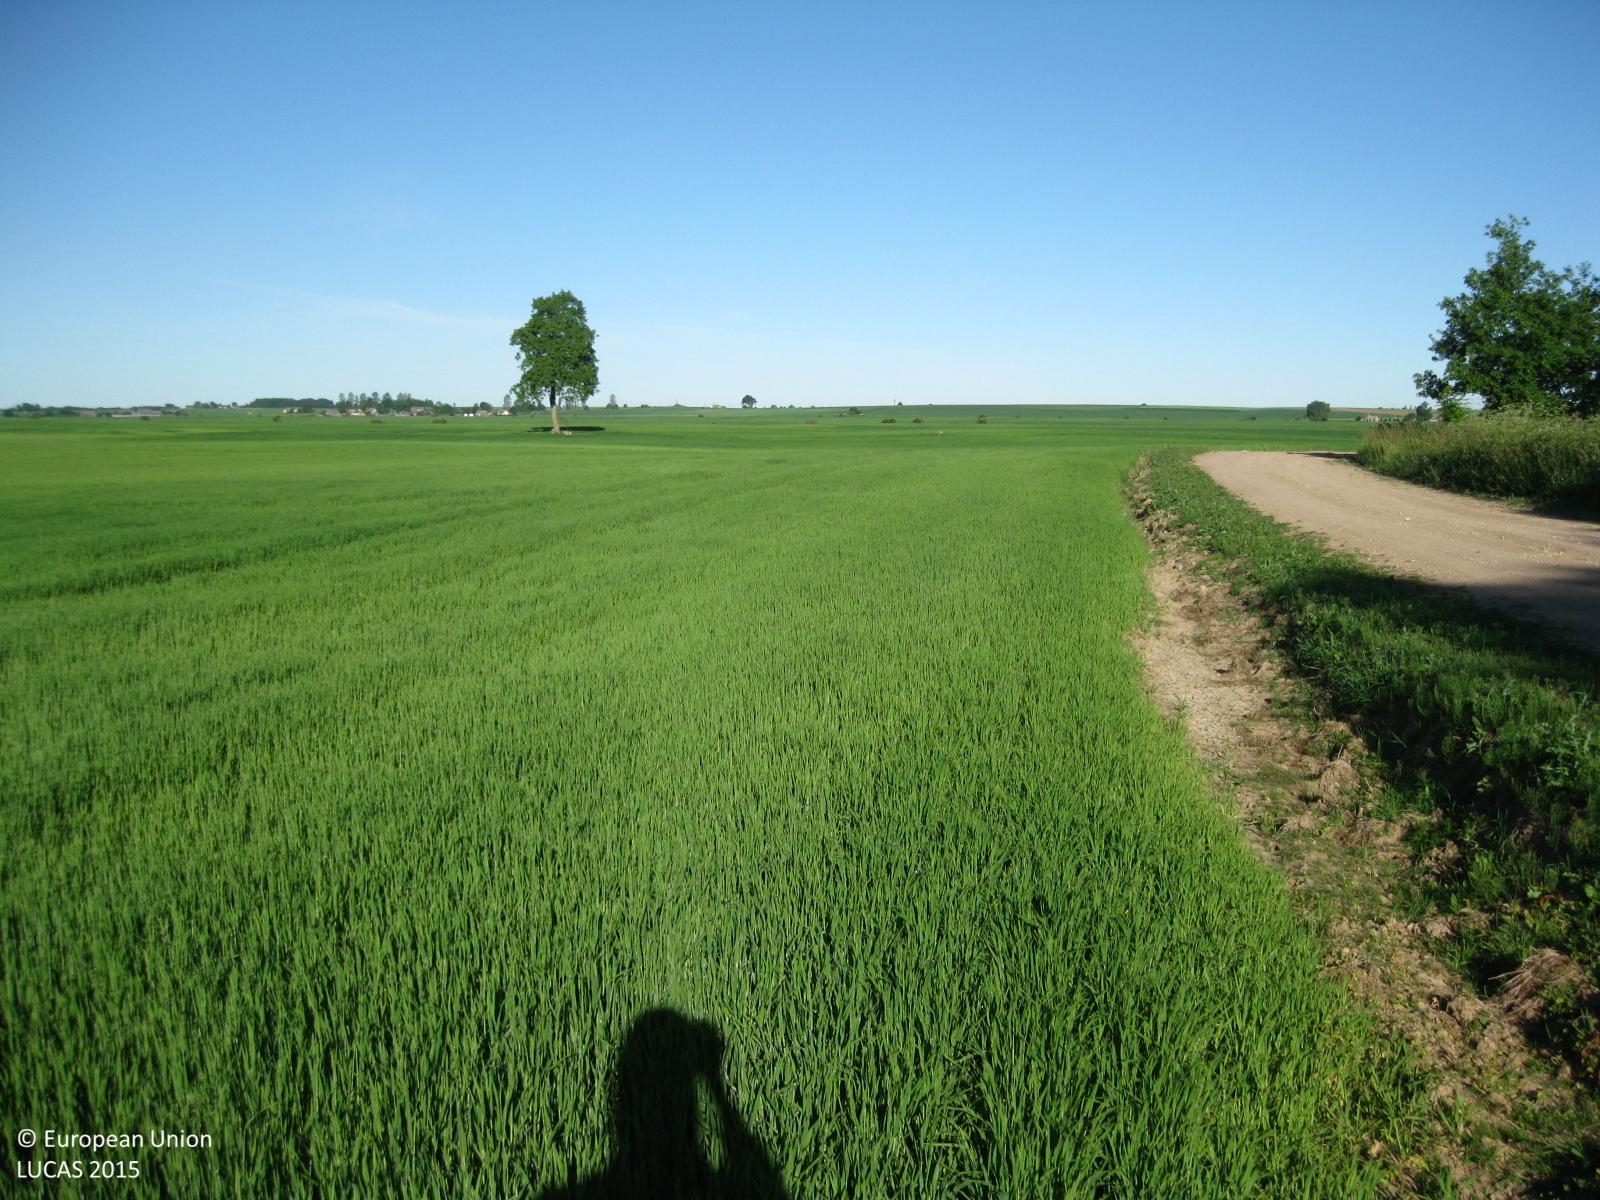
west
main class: Cropland
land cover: Common wheat
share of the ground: > 75 %
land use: Agriculture (excluding fallow land and kitchen gardens)
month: June
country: LT
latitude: 55.3363
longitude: 23.7209
